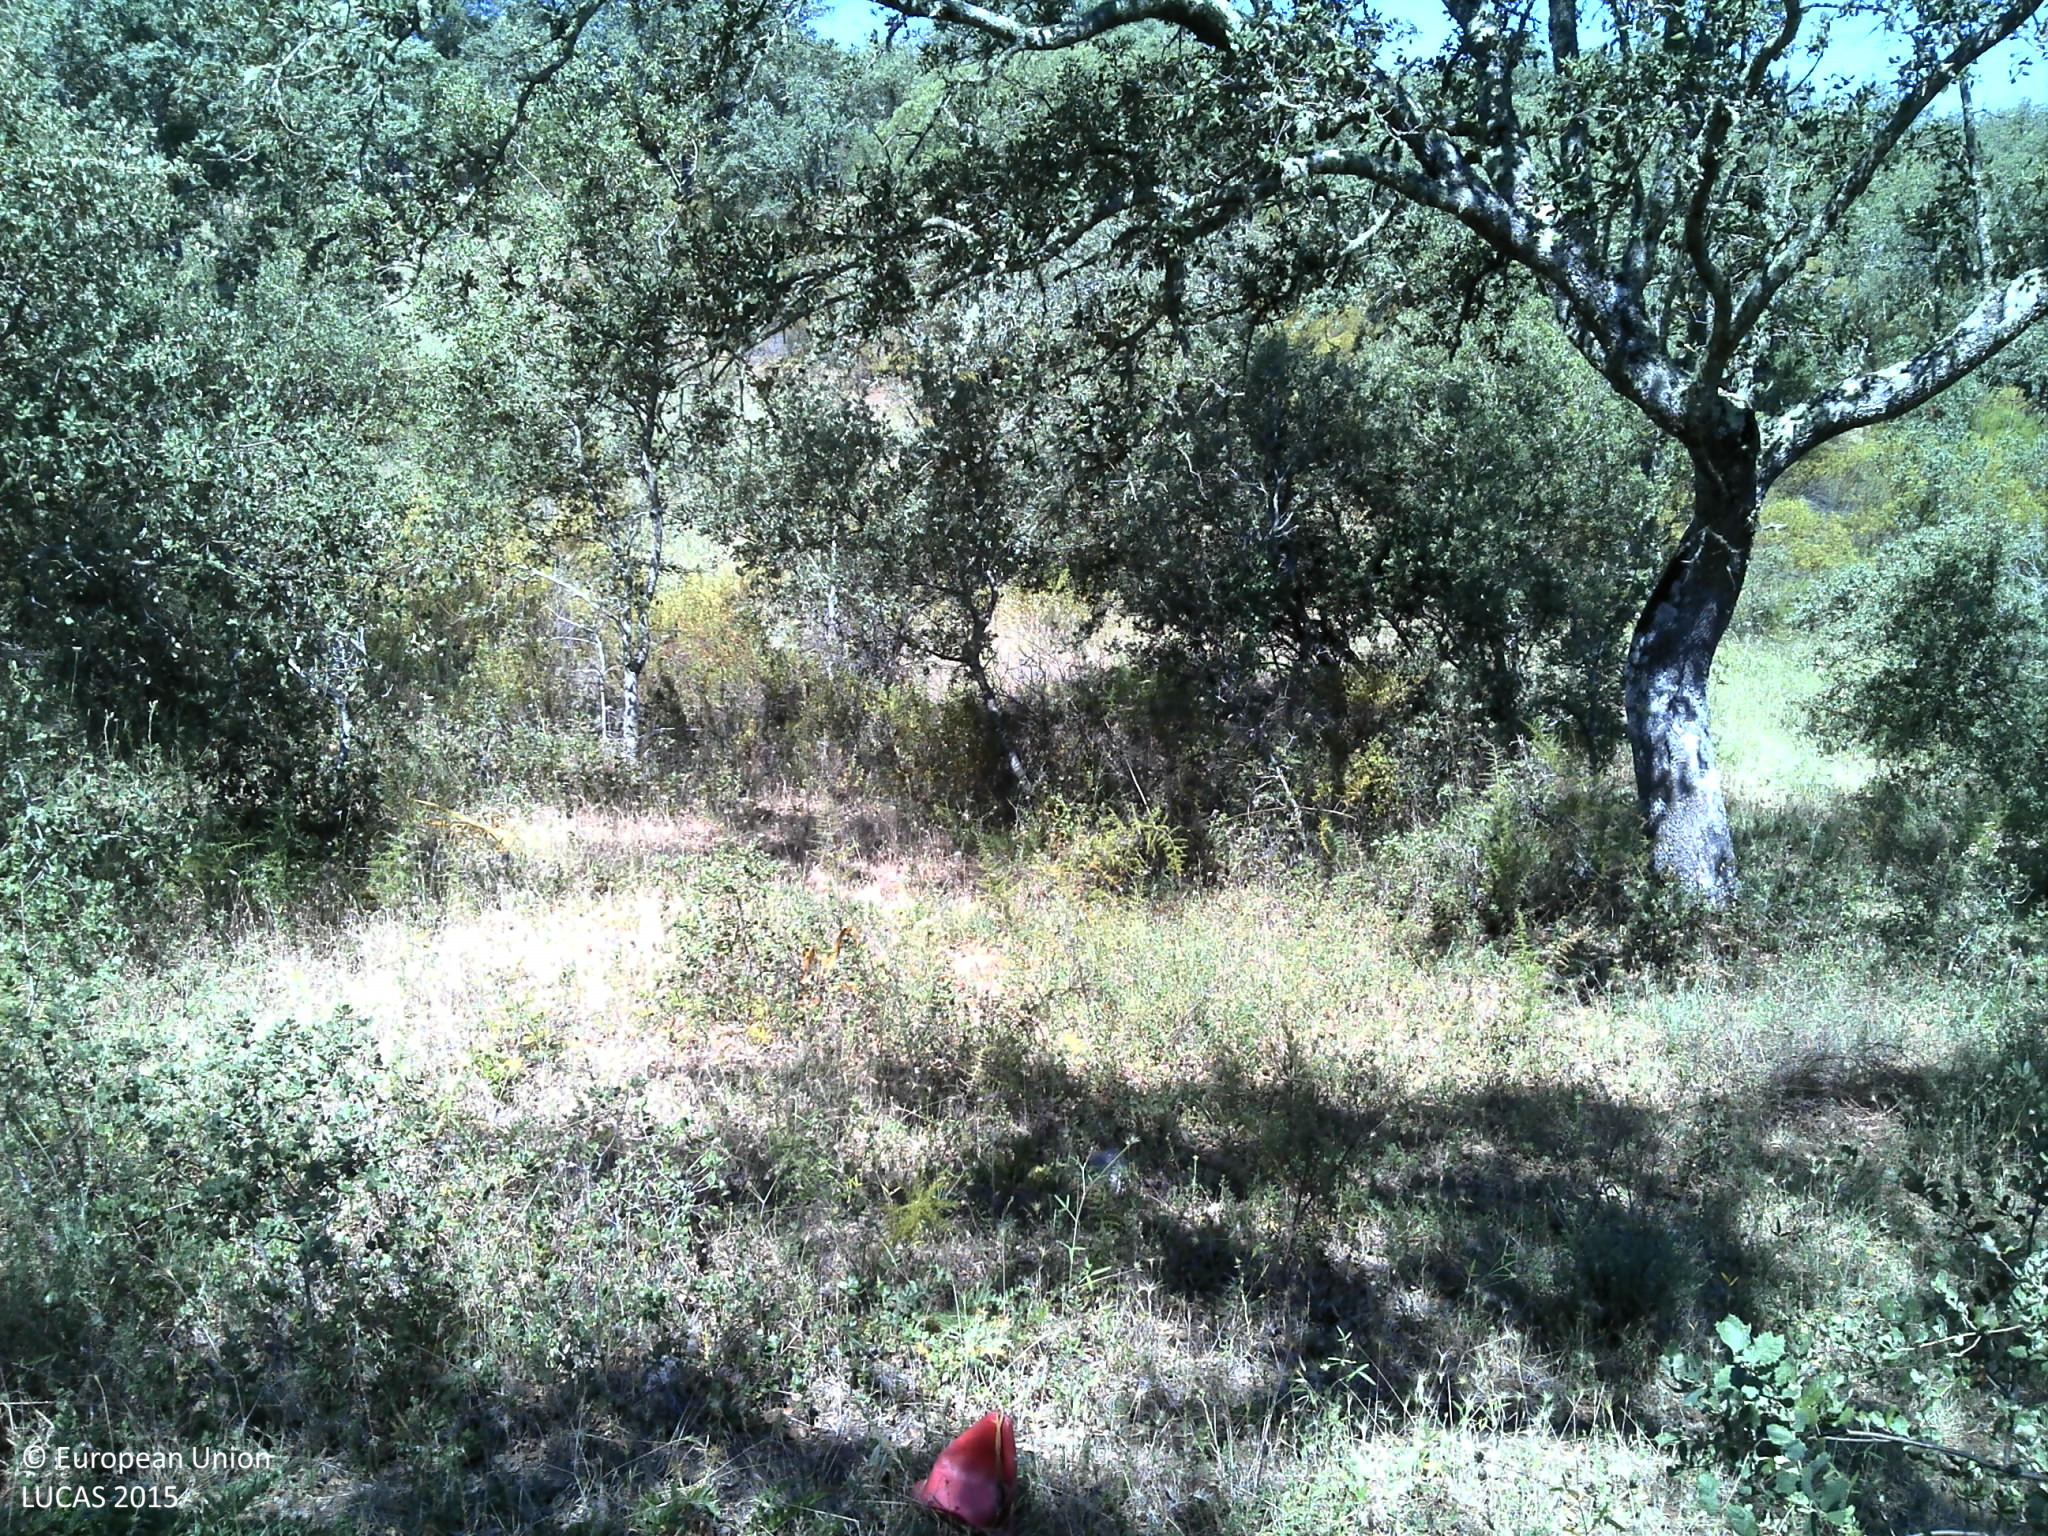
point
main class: Woodland
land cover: Broadleaved woodland
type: broadleaved evergreen forest
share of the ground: > 75 %
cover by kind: broadleaved forest trees 80 %, shrubs 20 %
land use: Forestry
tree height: > 5 m
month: May
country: PT
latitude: 38.8445
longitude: -8.1038
